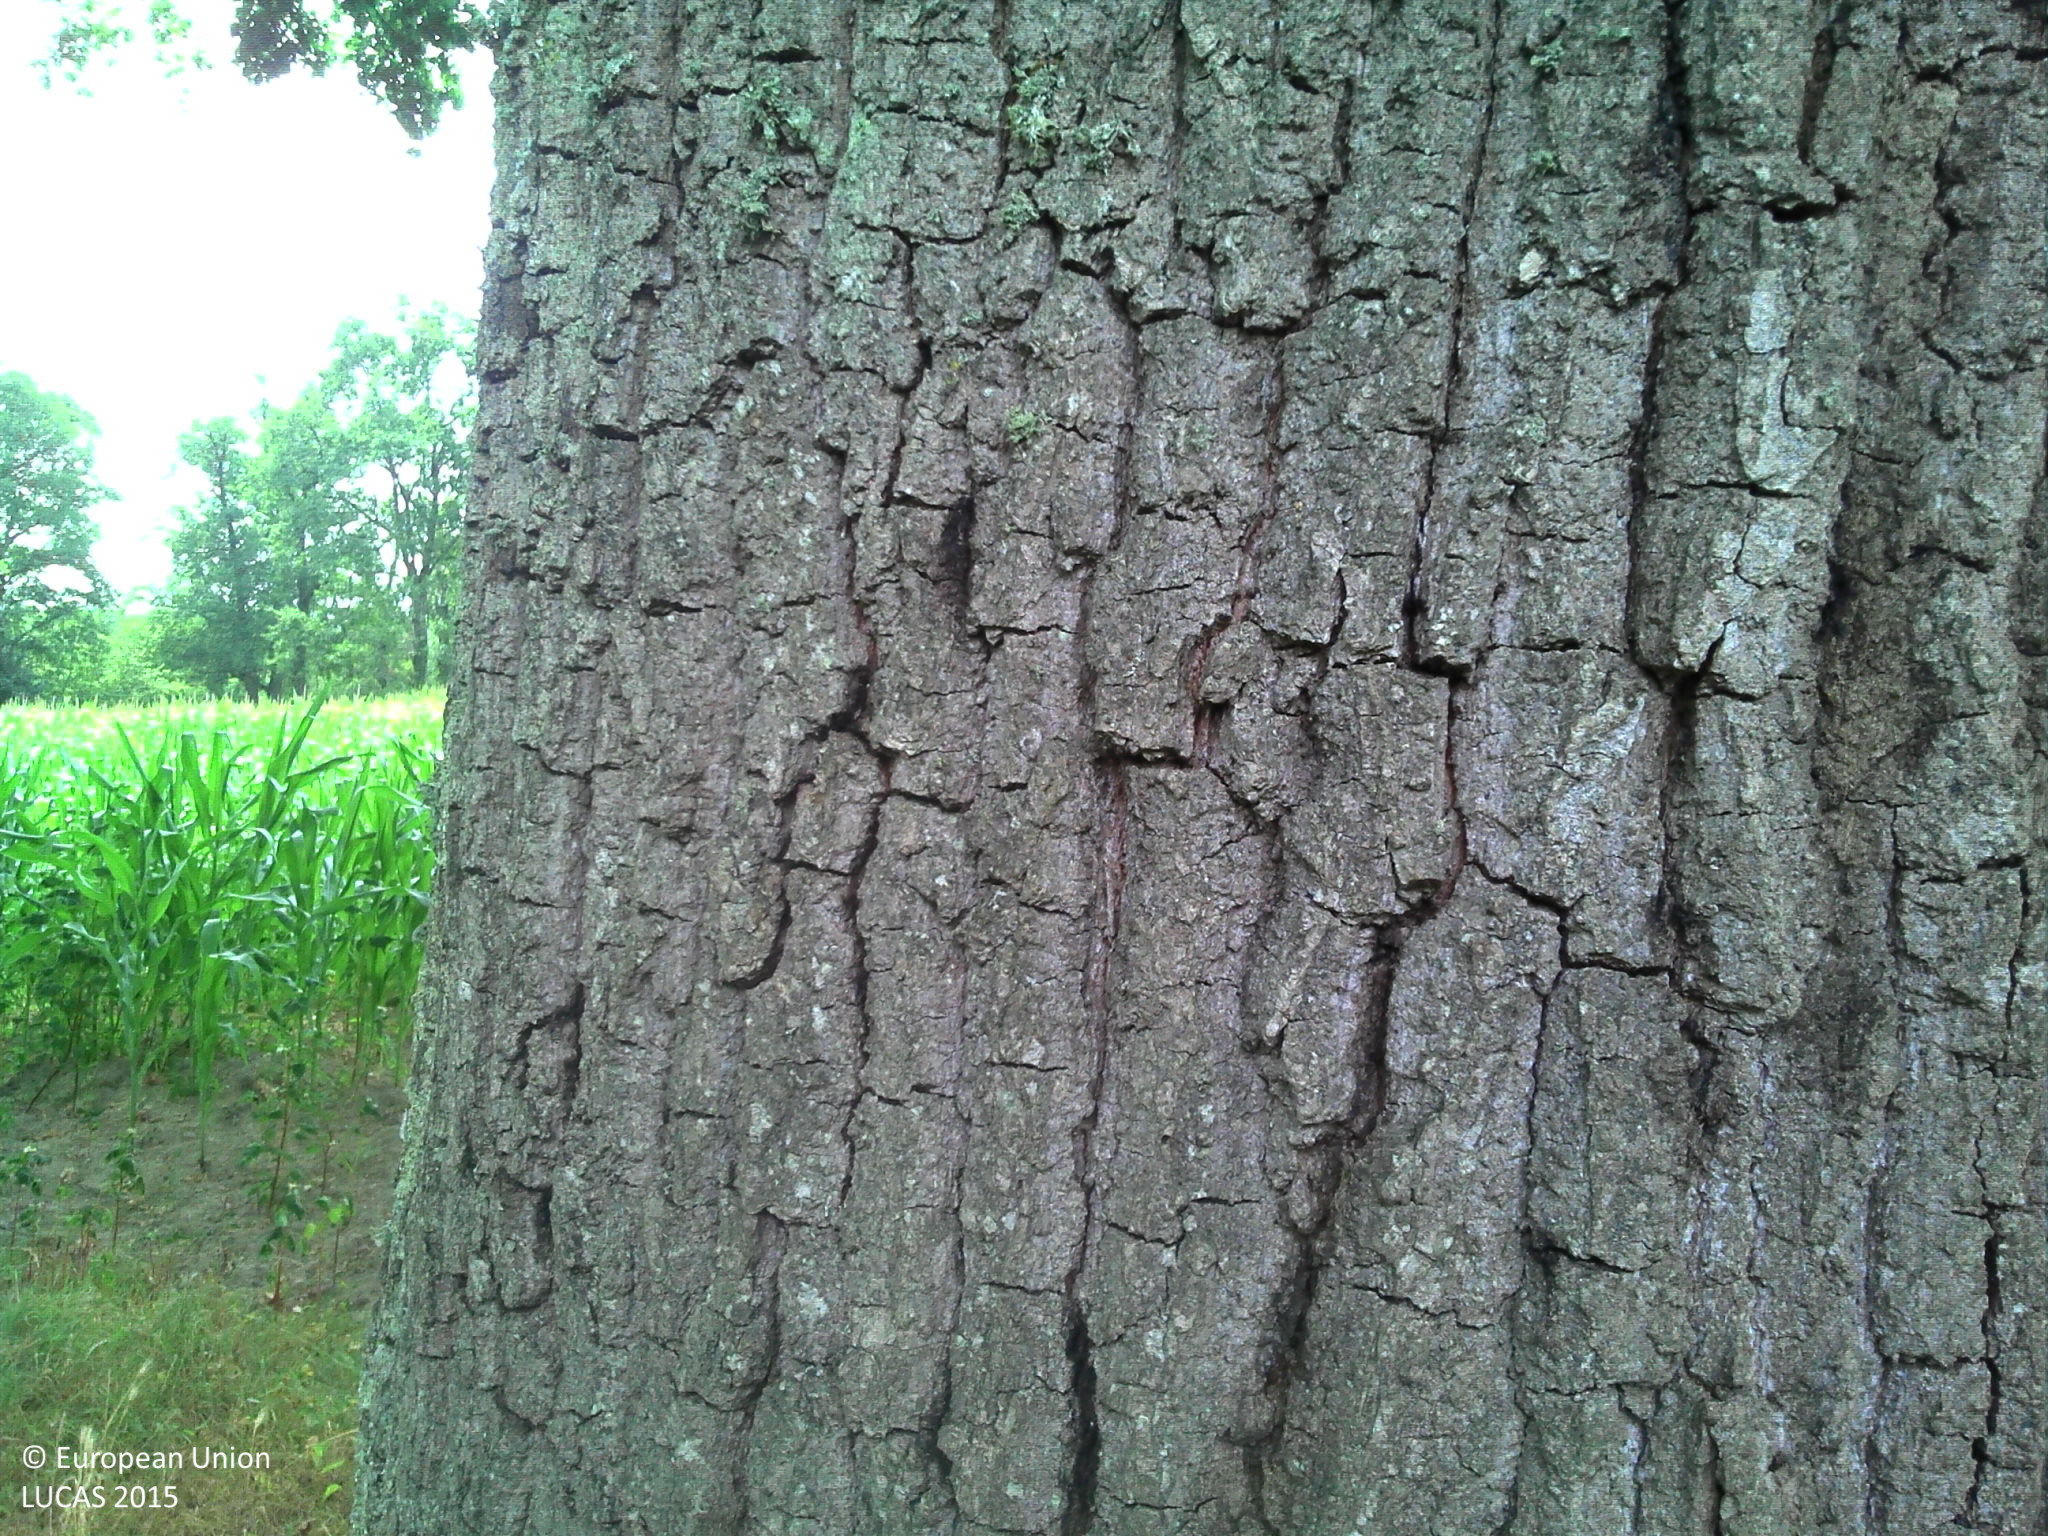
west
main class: Cropland
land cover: Maize
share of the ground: > 75 %
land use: Agriculture (excluding fallow land and kitchen gardens)
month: July
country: FR
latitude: 46.2429
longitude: 0.9997
